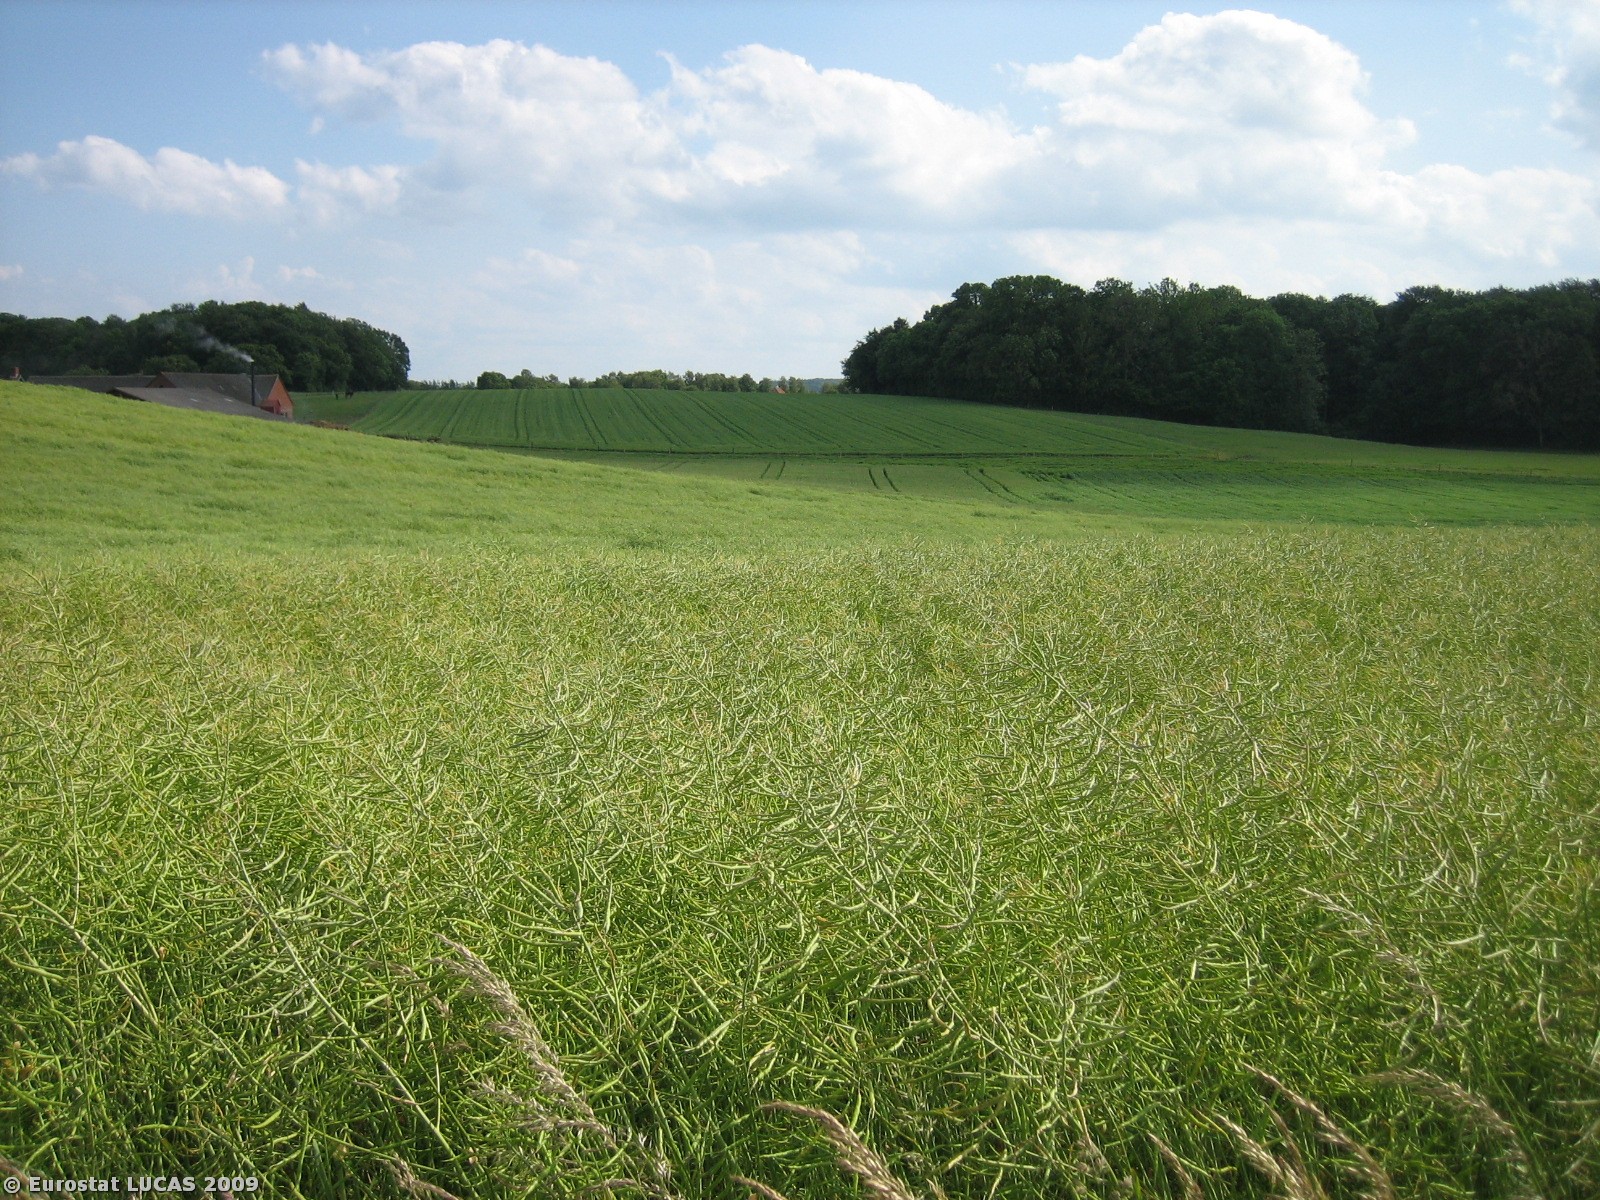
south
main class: Cropland
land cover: Rape and turnip rape
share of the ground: > 75 %
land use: Agriculture (excluding fallow land and kitchen gardens)
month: June
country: DK
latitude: 55.7563
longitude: 9.9841
